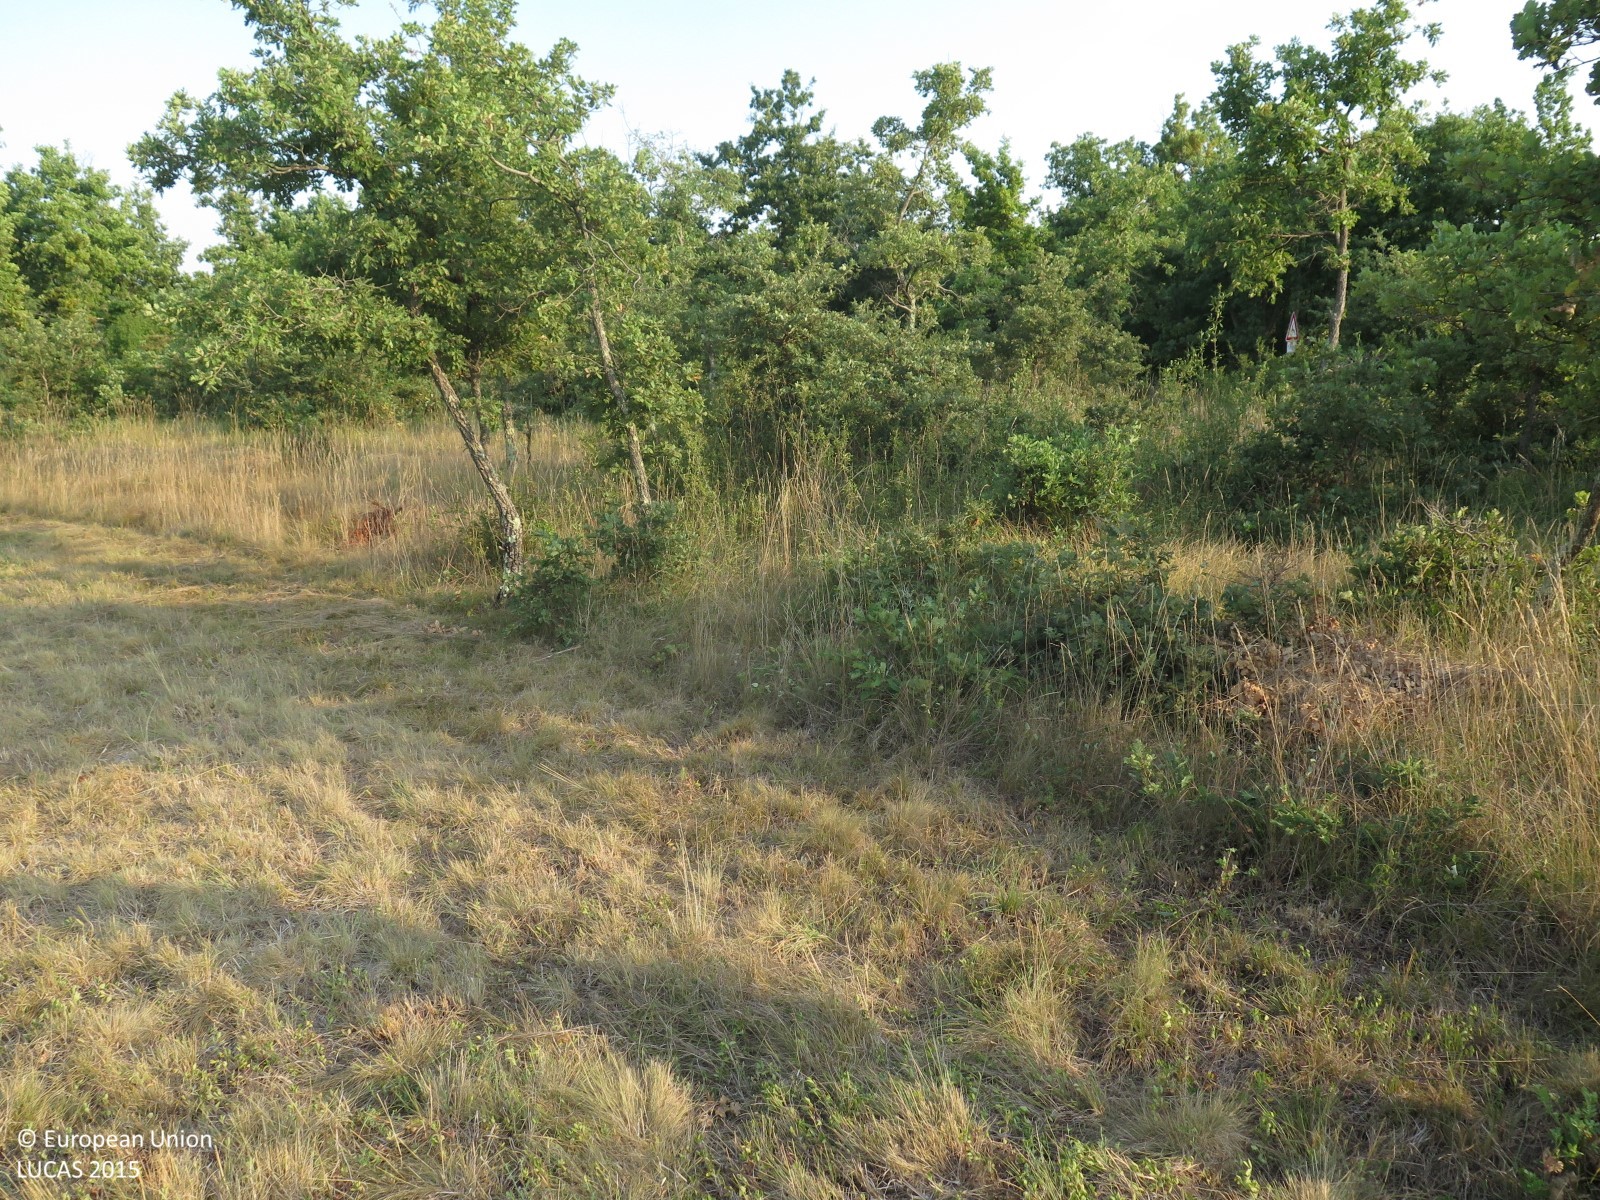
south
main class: Grassland
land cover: Grassland with sparse tree/shrub cover
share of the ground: > 75 %
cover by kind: herbaceous plants 85 %, shrubs 10 %, broadleaved forest trees 5 %
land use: Semi-natural and natural areas not in use
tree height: < 5 m
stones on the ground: < 10 %
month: July
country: HR
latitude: 45.2573
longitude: 13.7541
